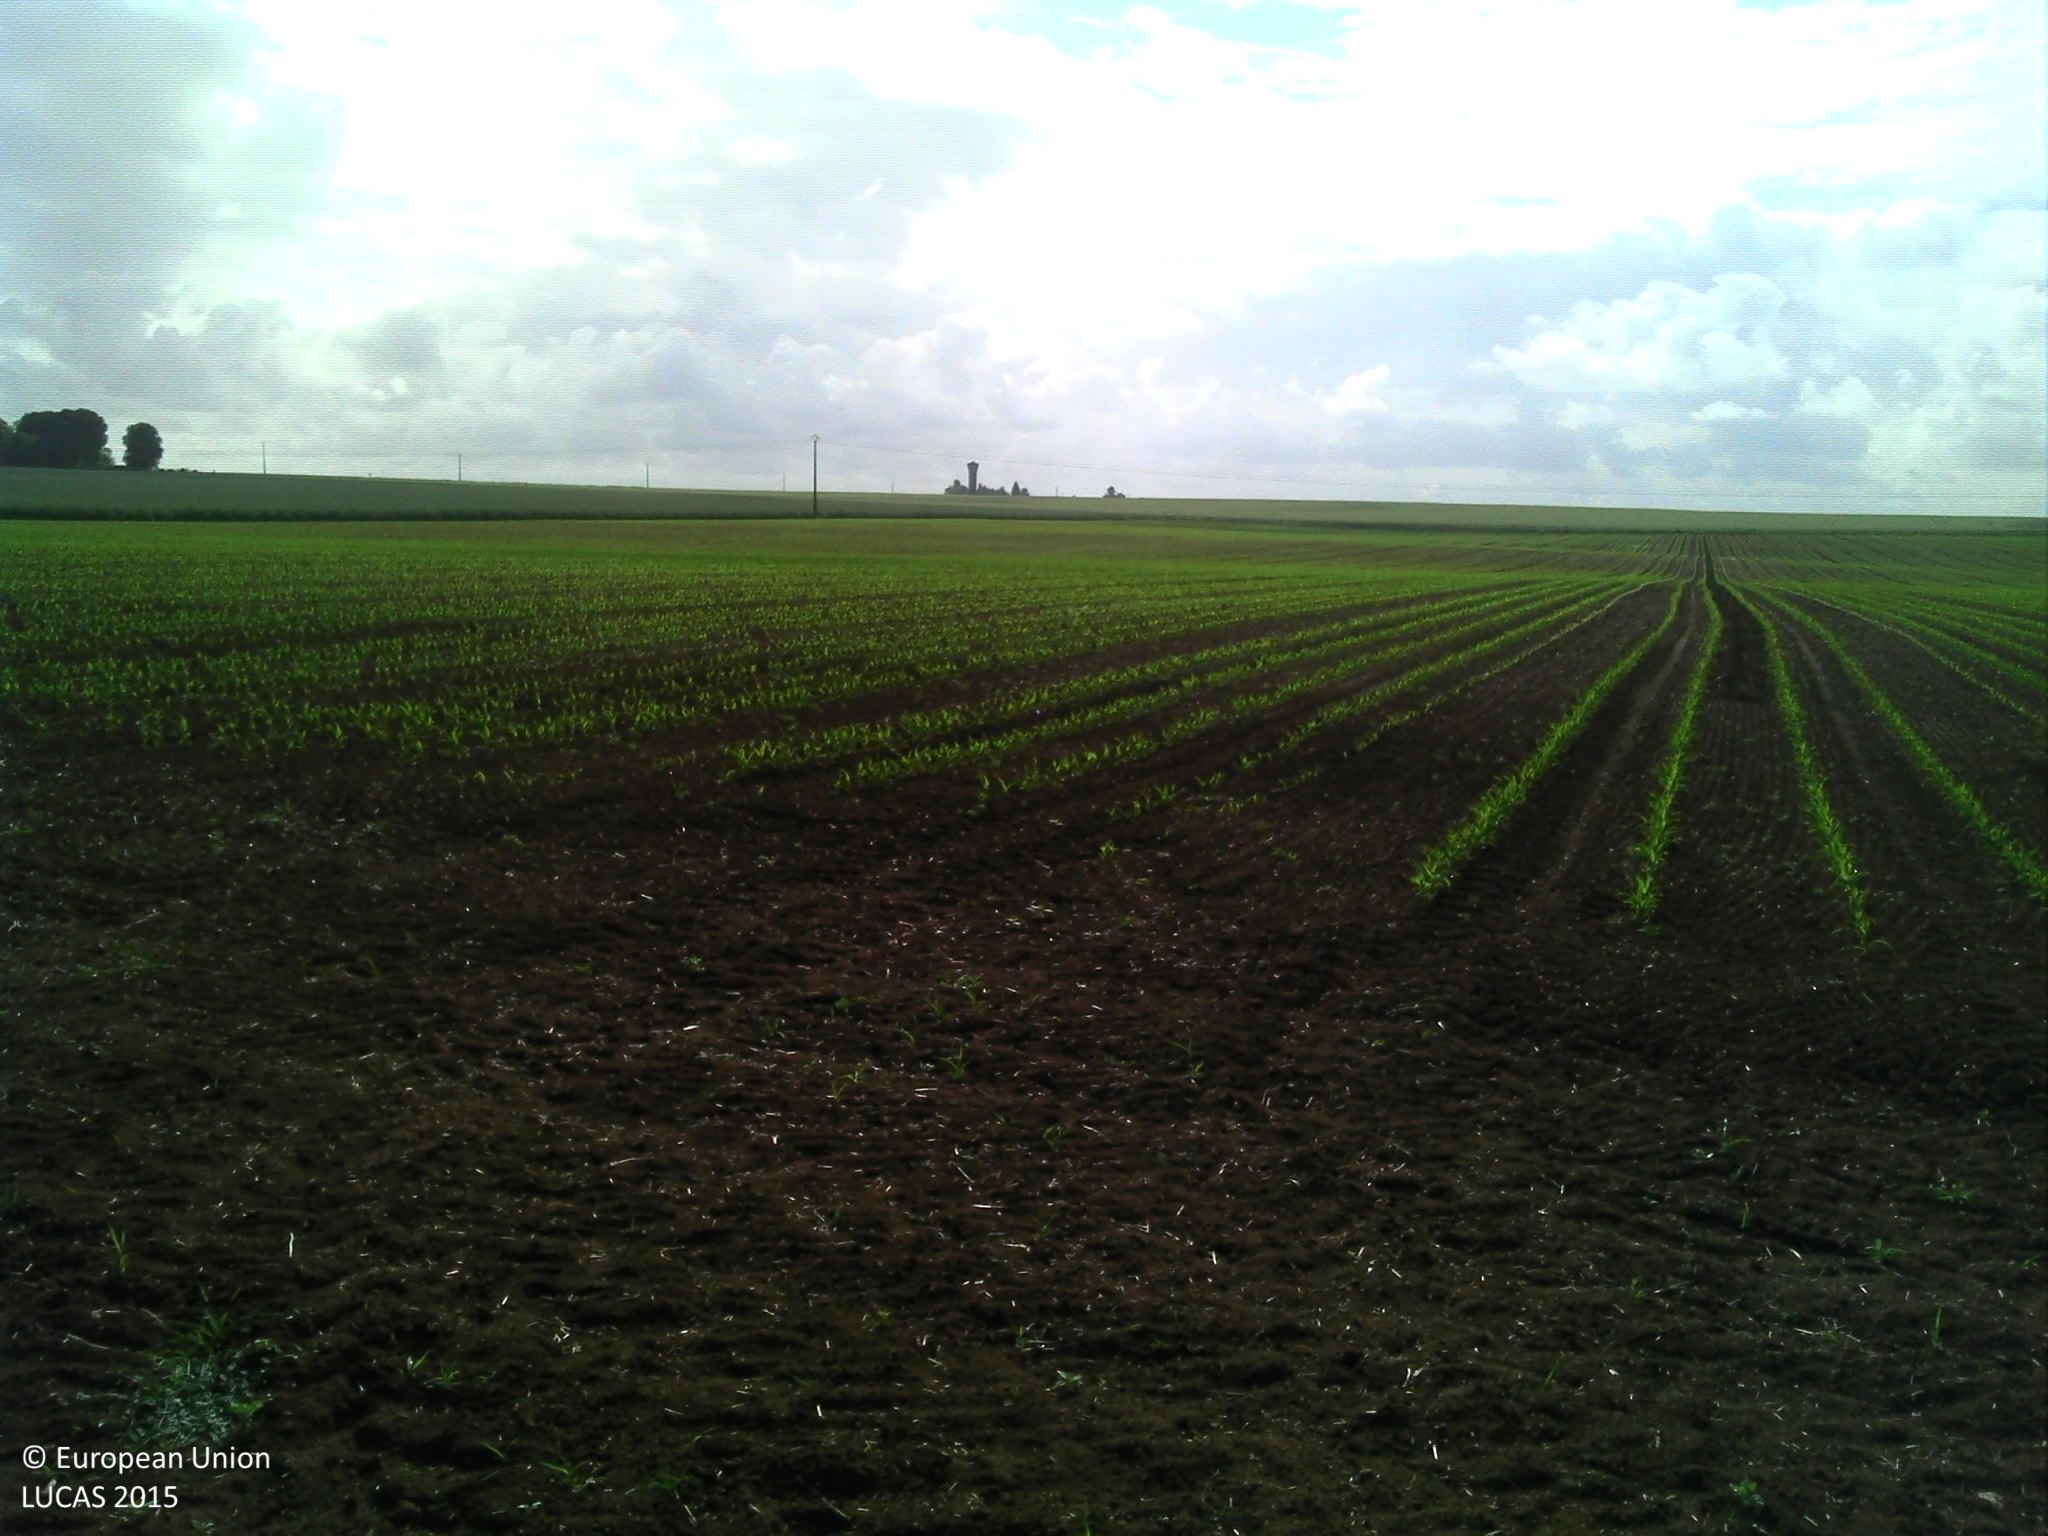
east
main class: Cropland
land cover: Rape and turnip rape
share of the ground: > 75 %
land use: Agriculture (excluding fallow land and kitchen gardens)
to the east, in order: Rape and turnip rape; Maize
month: June
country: FR
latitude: 47.2425
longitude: 1.0400
